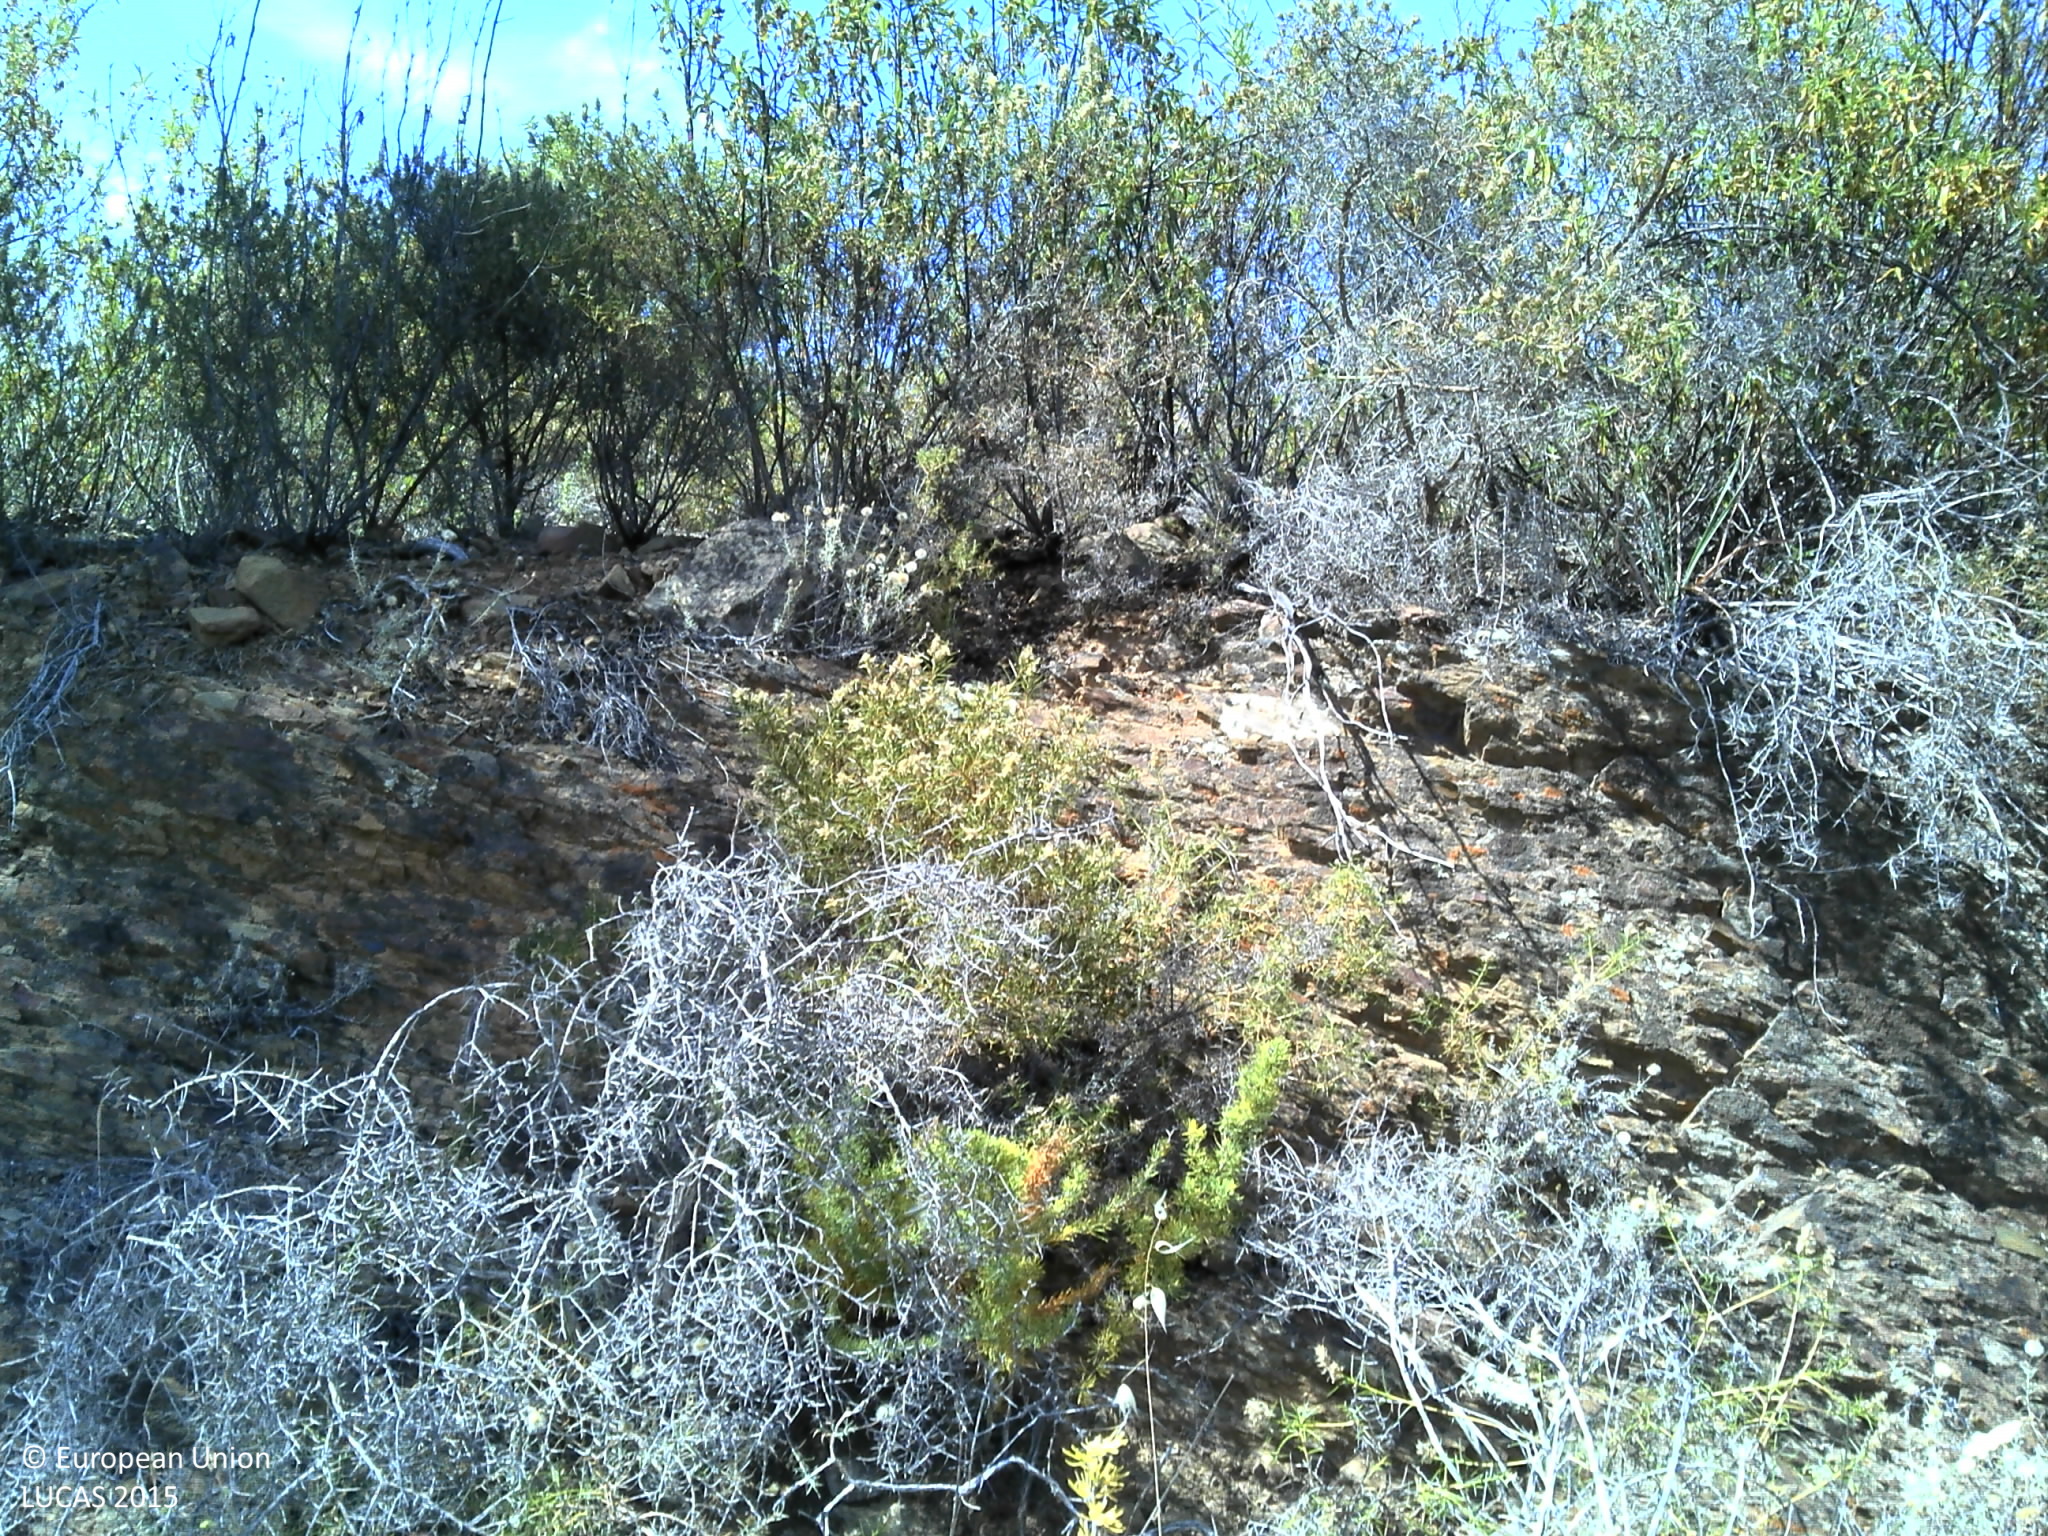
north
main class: Shrubland
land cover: Shrubland with sparse tree cover
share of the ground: > 75 %
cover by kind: shrubs 85 %, broadleaved forest trees 5 %, herbaceous plants 5 %
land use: Abandoned areas
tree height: < 5 m
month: May
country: PT
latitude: 37.3204
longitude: -7.4620
